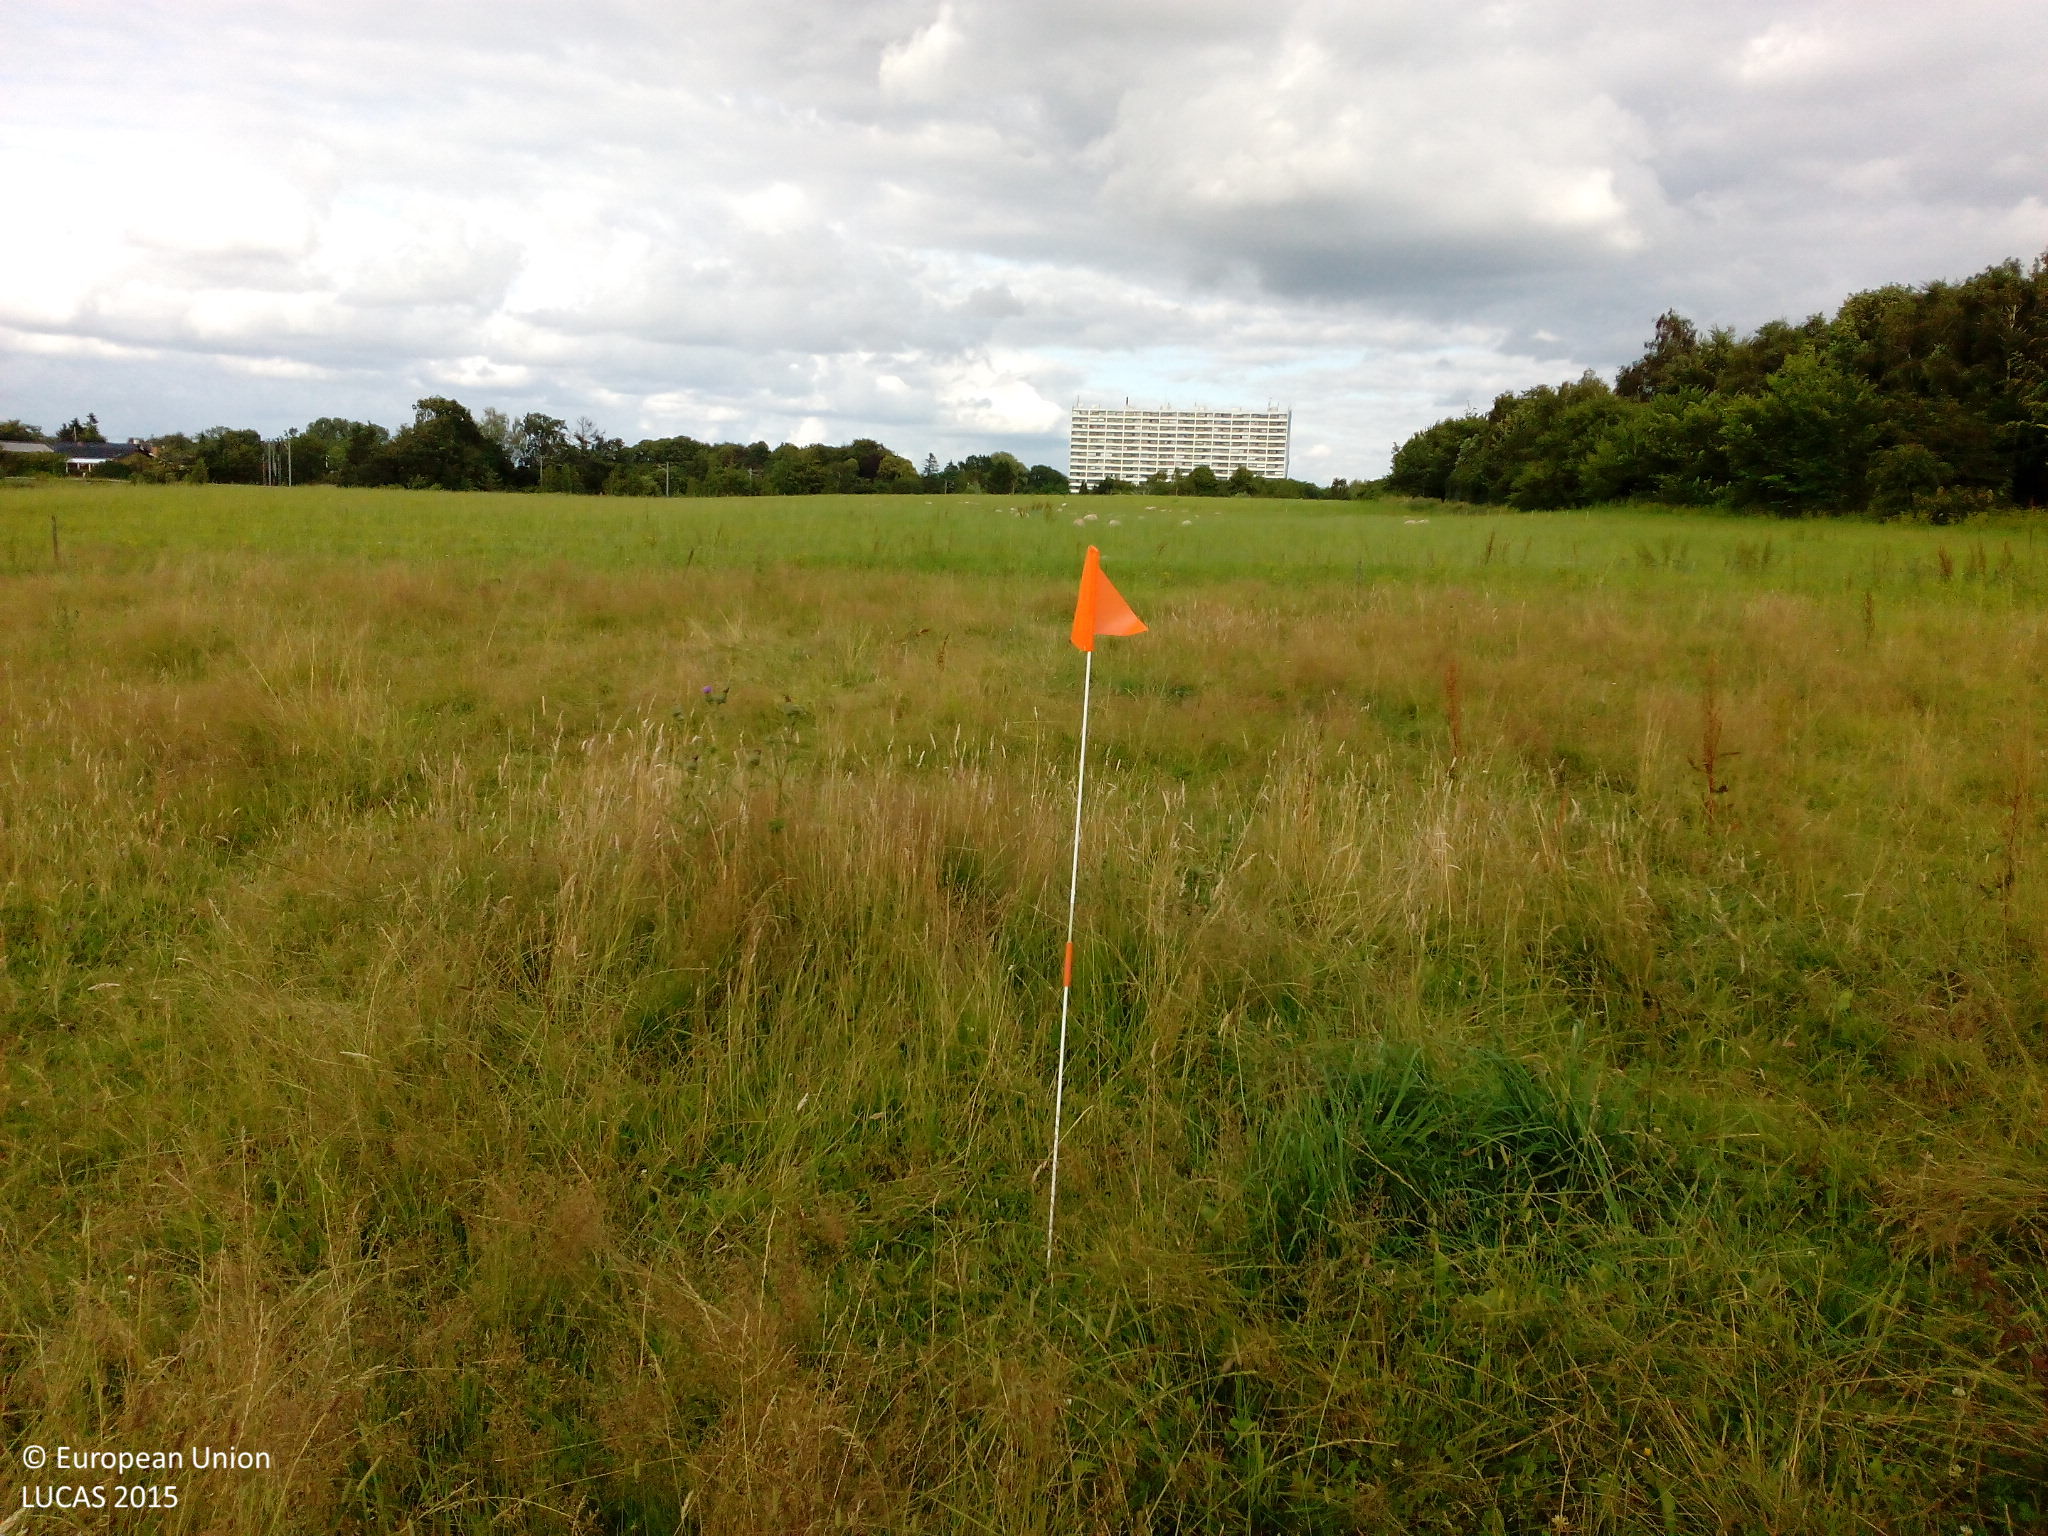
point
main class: Grassland
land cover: Grassland without tree/shrub cover
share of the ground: > 75 %
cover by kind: herbaceous plants 100 %
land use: Agriculture (excluding fallow land and kitchen gardens)
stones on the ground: < 10 %
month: July
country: DK
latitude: 55.7349
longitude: 12.3391
